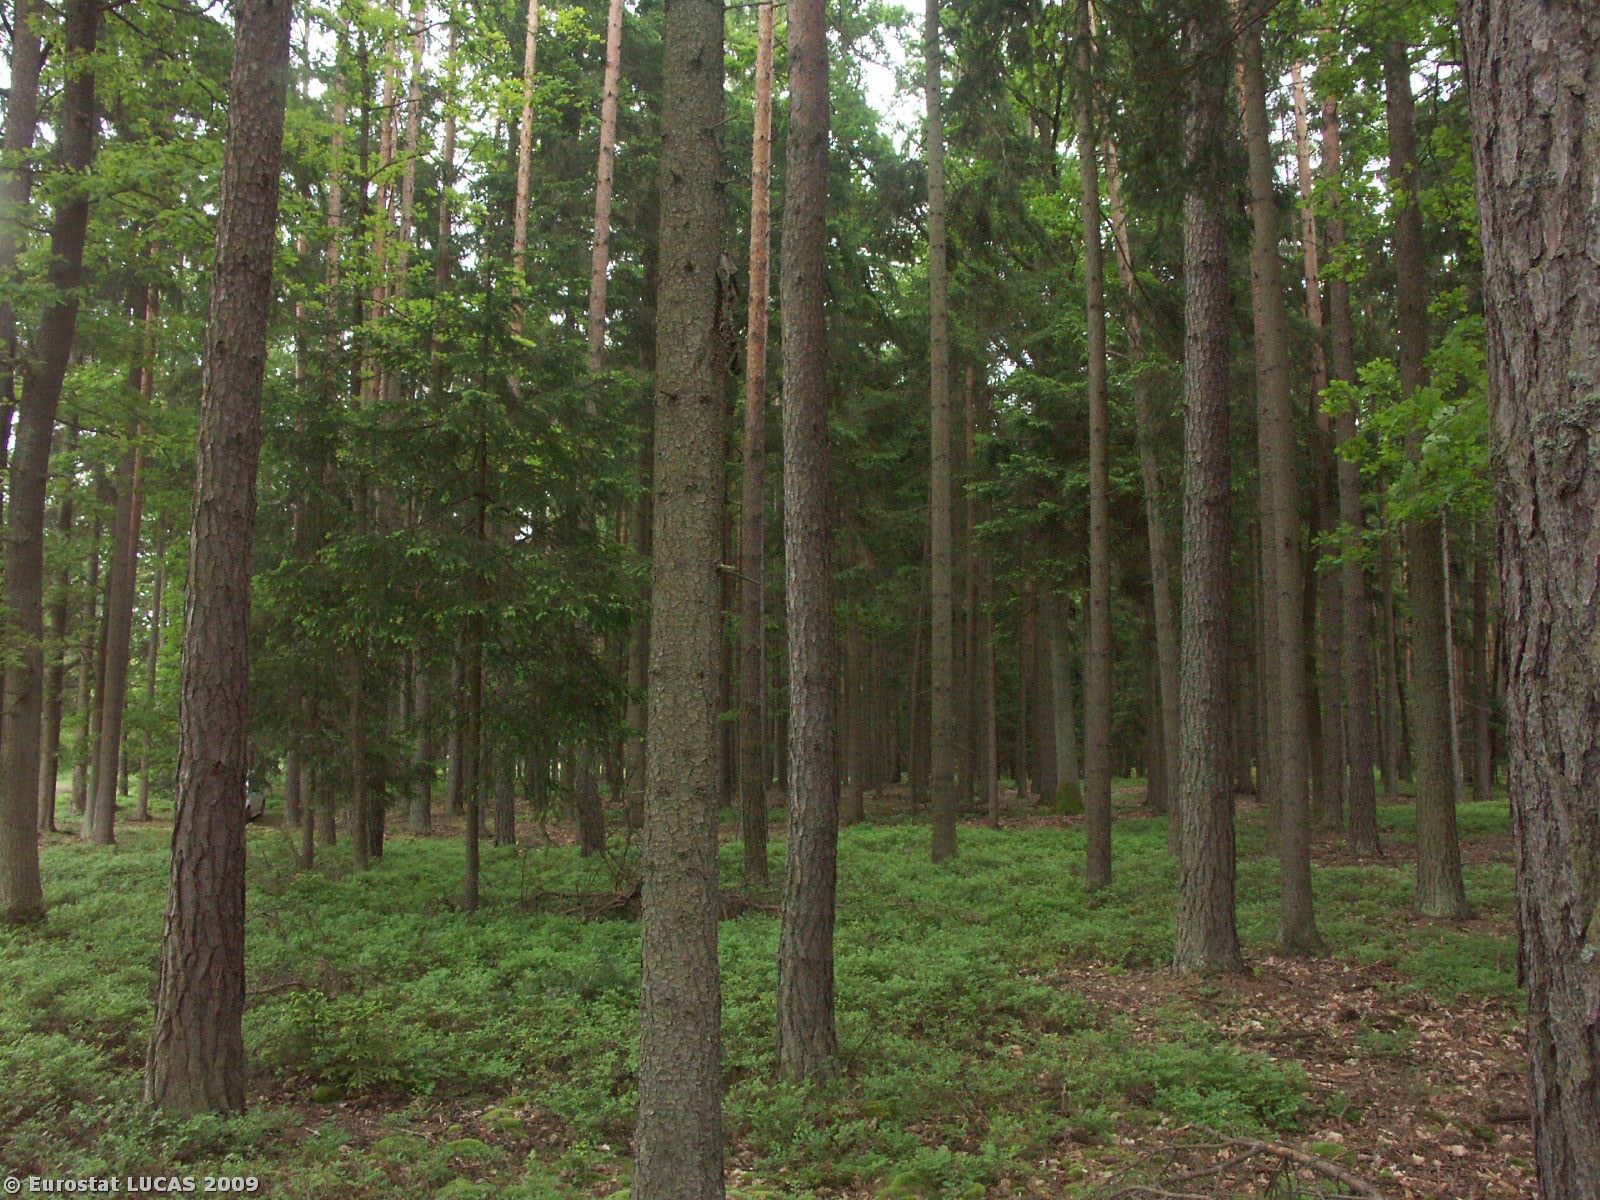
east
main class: Woodland
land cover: Mixed woodland
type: hemiboreal forest and nemoral coniferous forest and mixed broadleaved-coniferous forest
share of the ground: > 75 %
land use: Forestry
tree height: > 5 m
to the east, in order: Mixed woodland; Tracks; Coniferous woodland; Tracks; Mixed woodland; Ditches and canals; Mixed woodland
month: May
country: CZ
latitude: 49.0068
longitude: 14.6905
